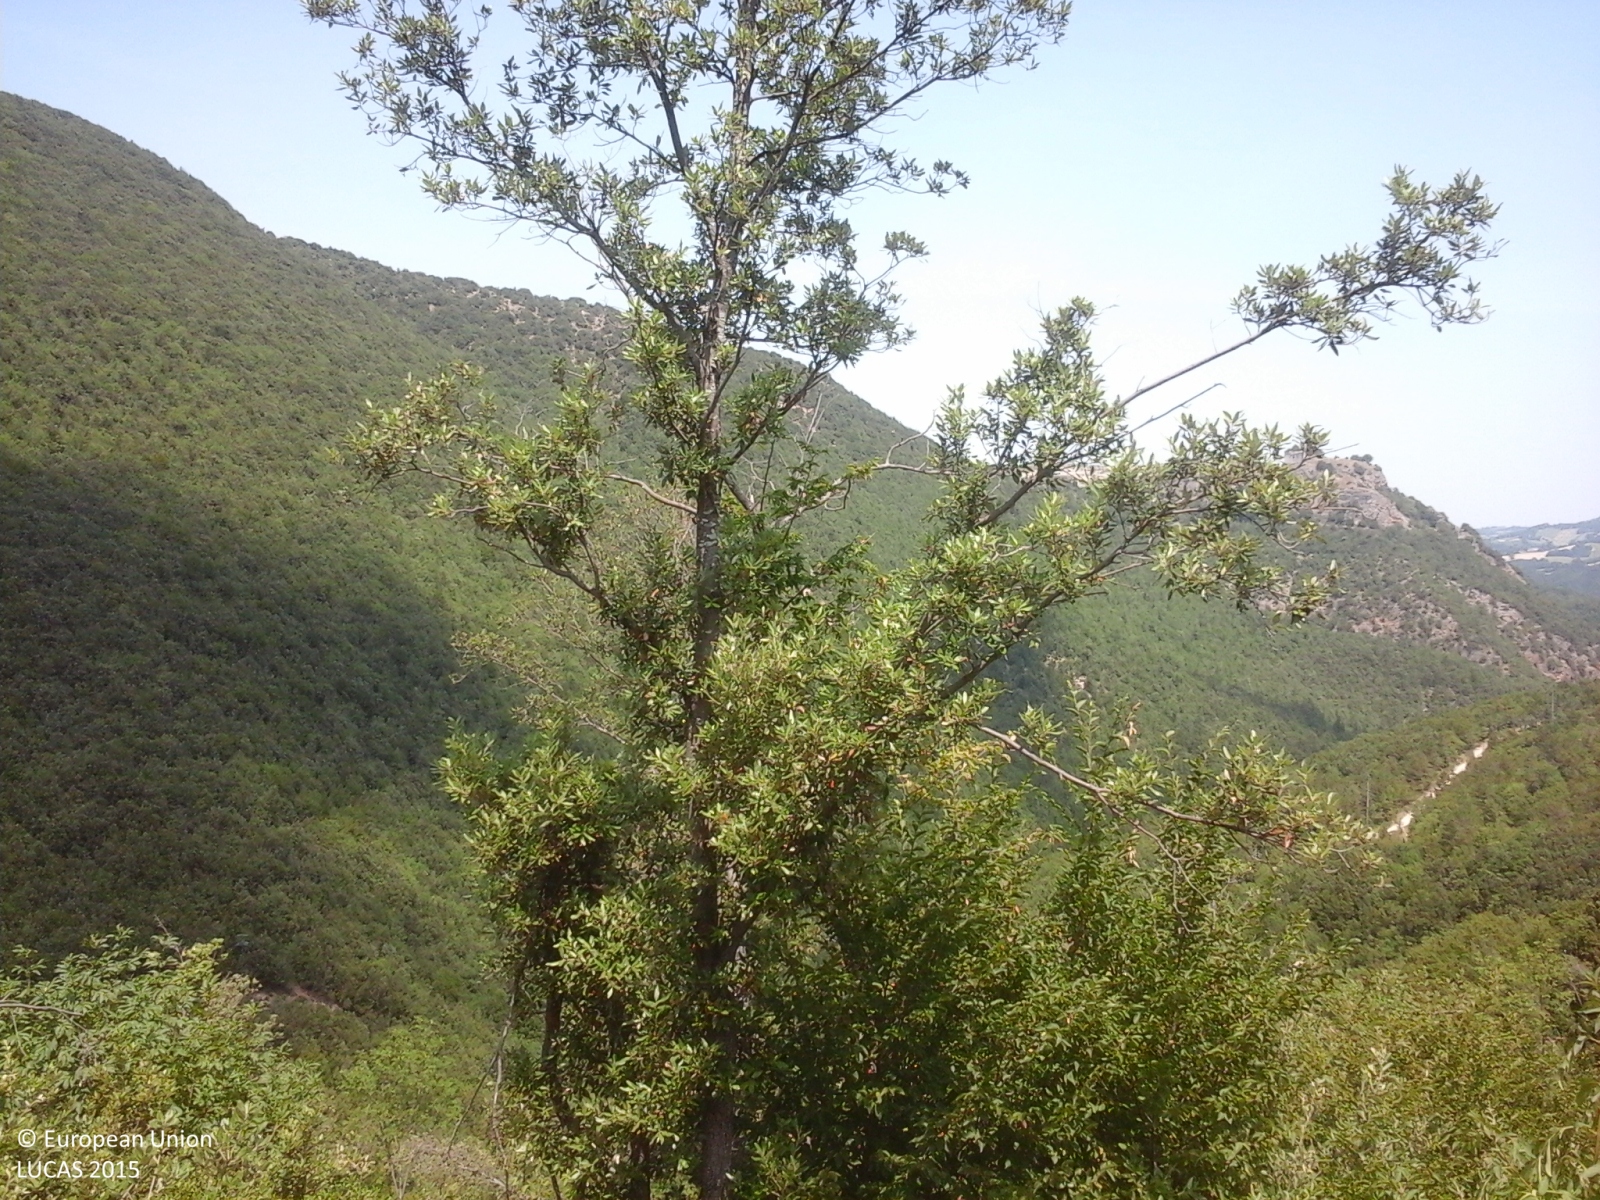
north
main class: Woodland
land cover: Broadleaved woodland
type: thermophilous deciduous forest
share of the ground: > 75 %
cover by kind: broadleaved forest trees 90 %, shrubs 5 %, herbaceous plants 5 %
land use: Forestry
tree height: > 5 m
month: July
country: IT
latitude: 43.0719
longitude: 13.2455
